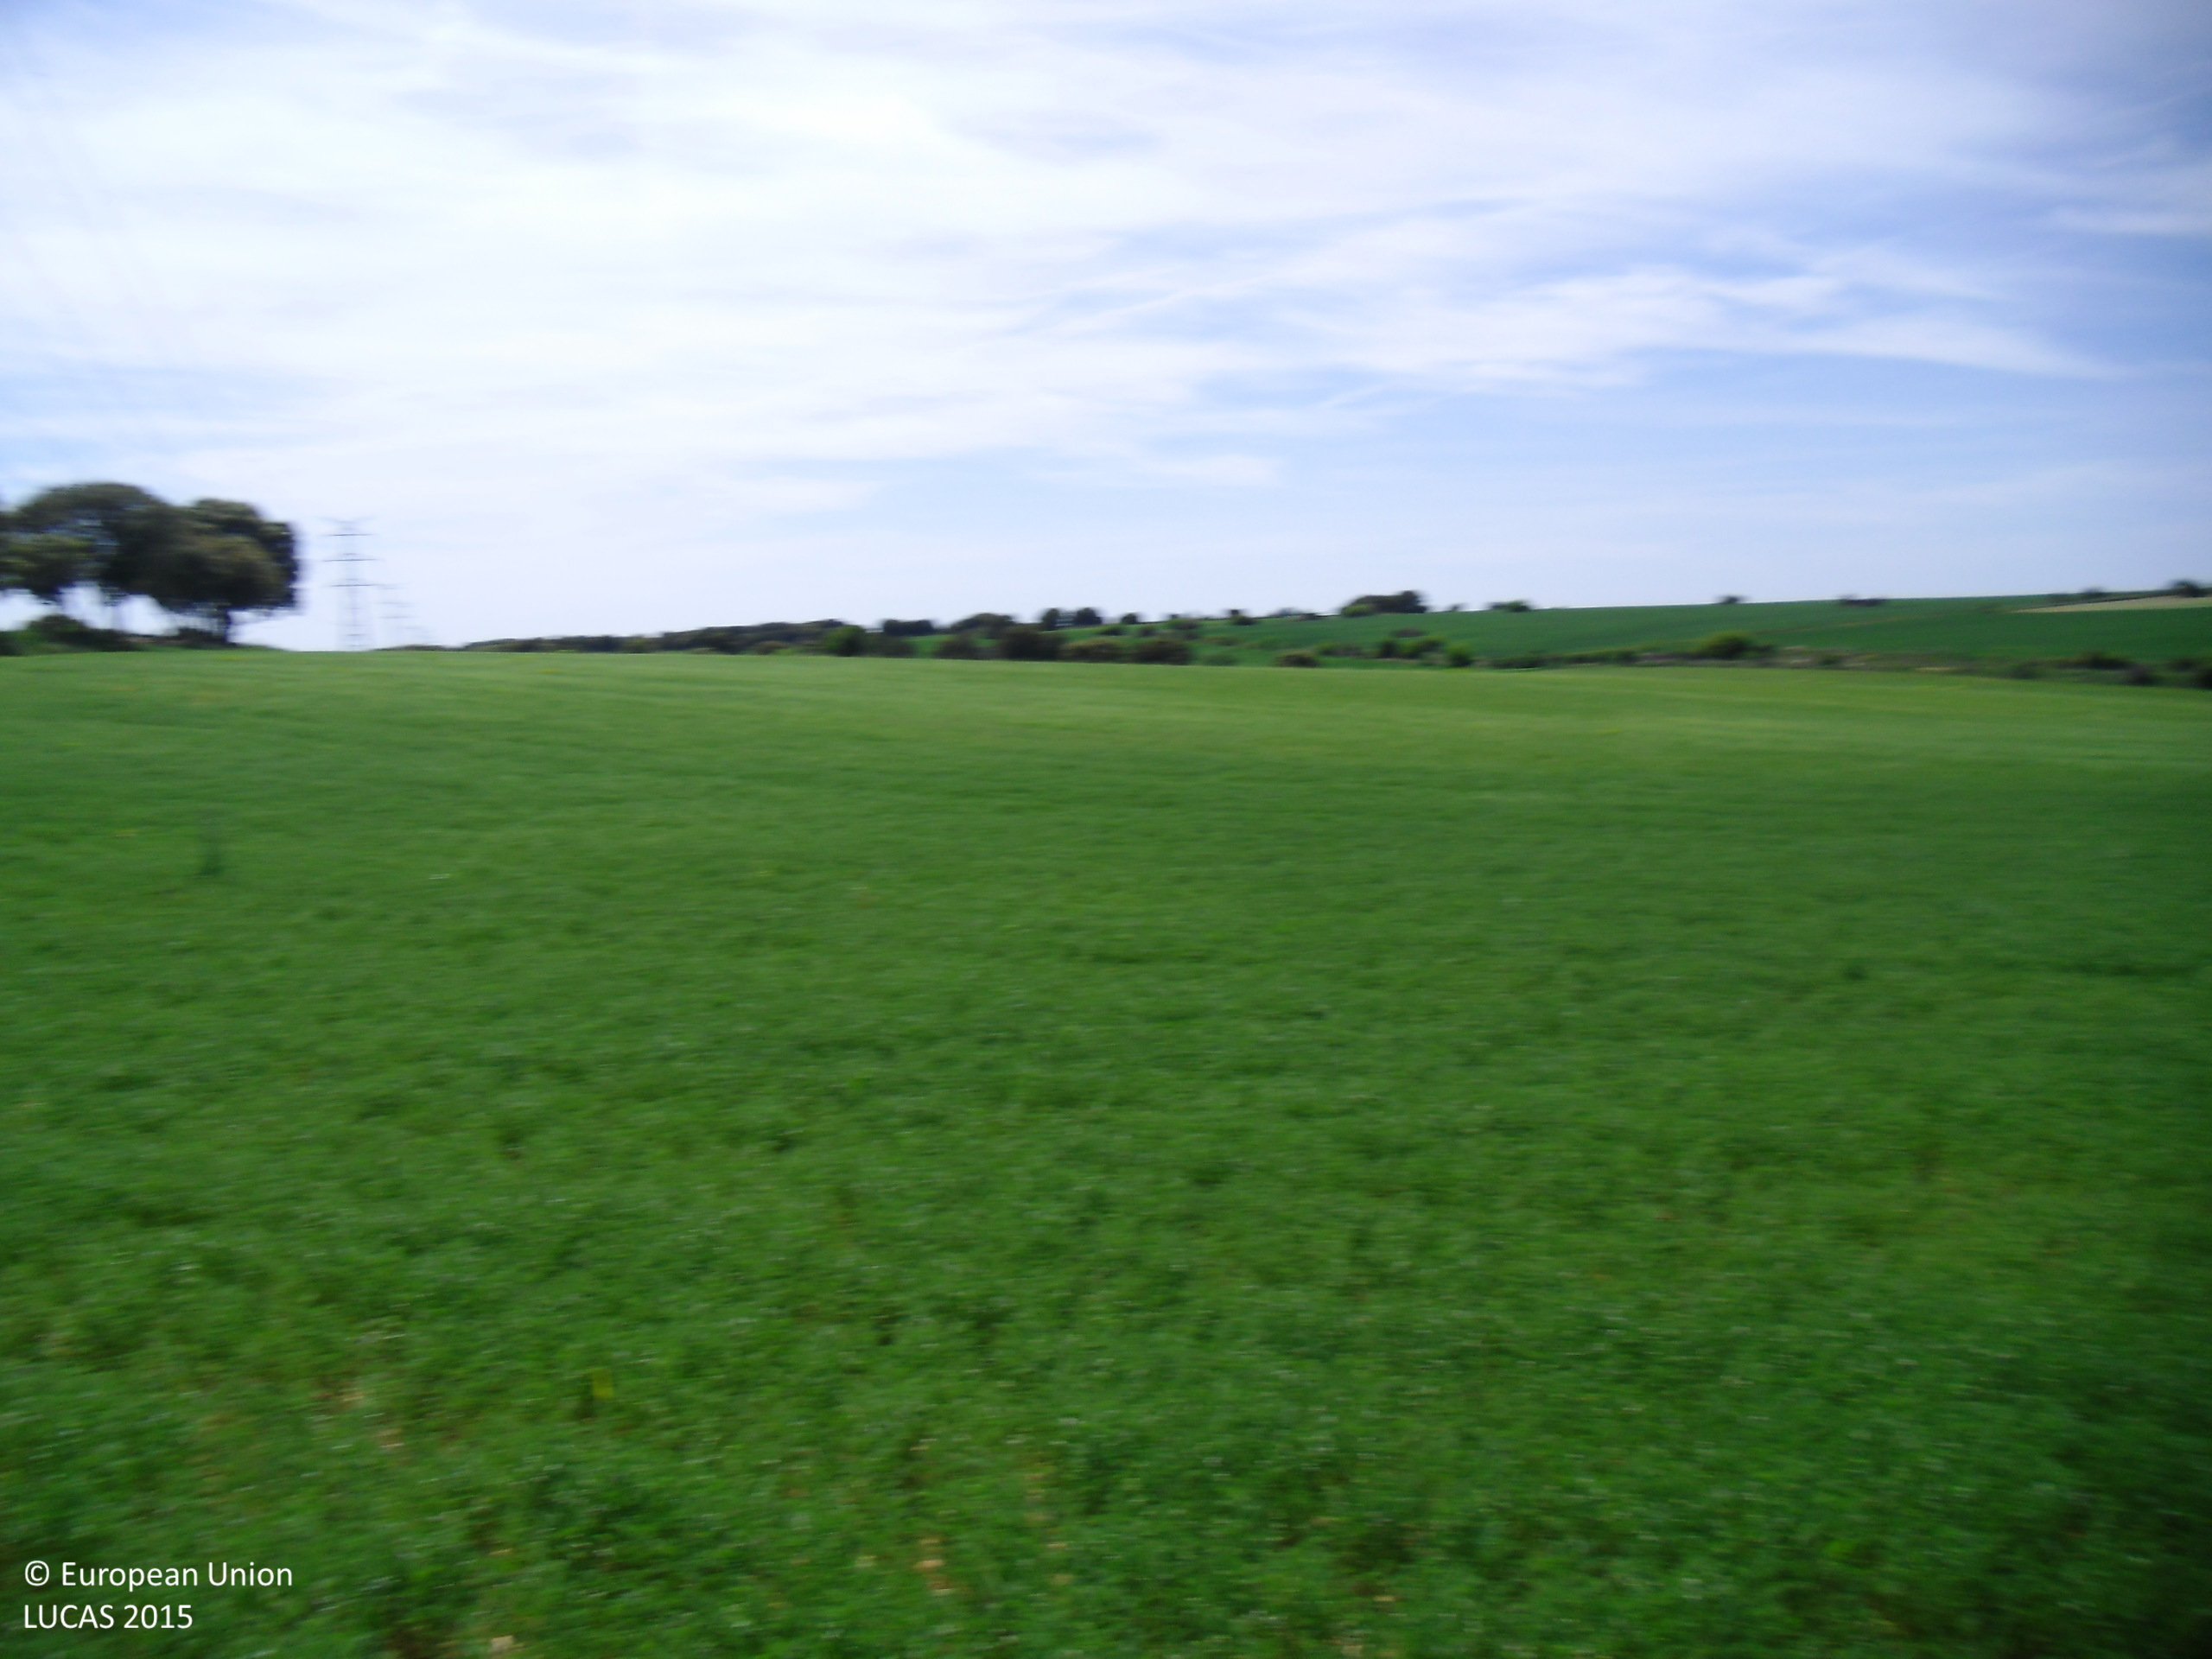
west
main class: Cropland
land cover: Dry pulses
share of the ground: > 75 %
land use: Agriculture (excluding fallow land and kitchen gardens)
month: May
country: ES
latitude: 40.6071
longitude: -2.8526
